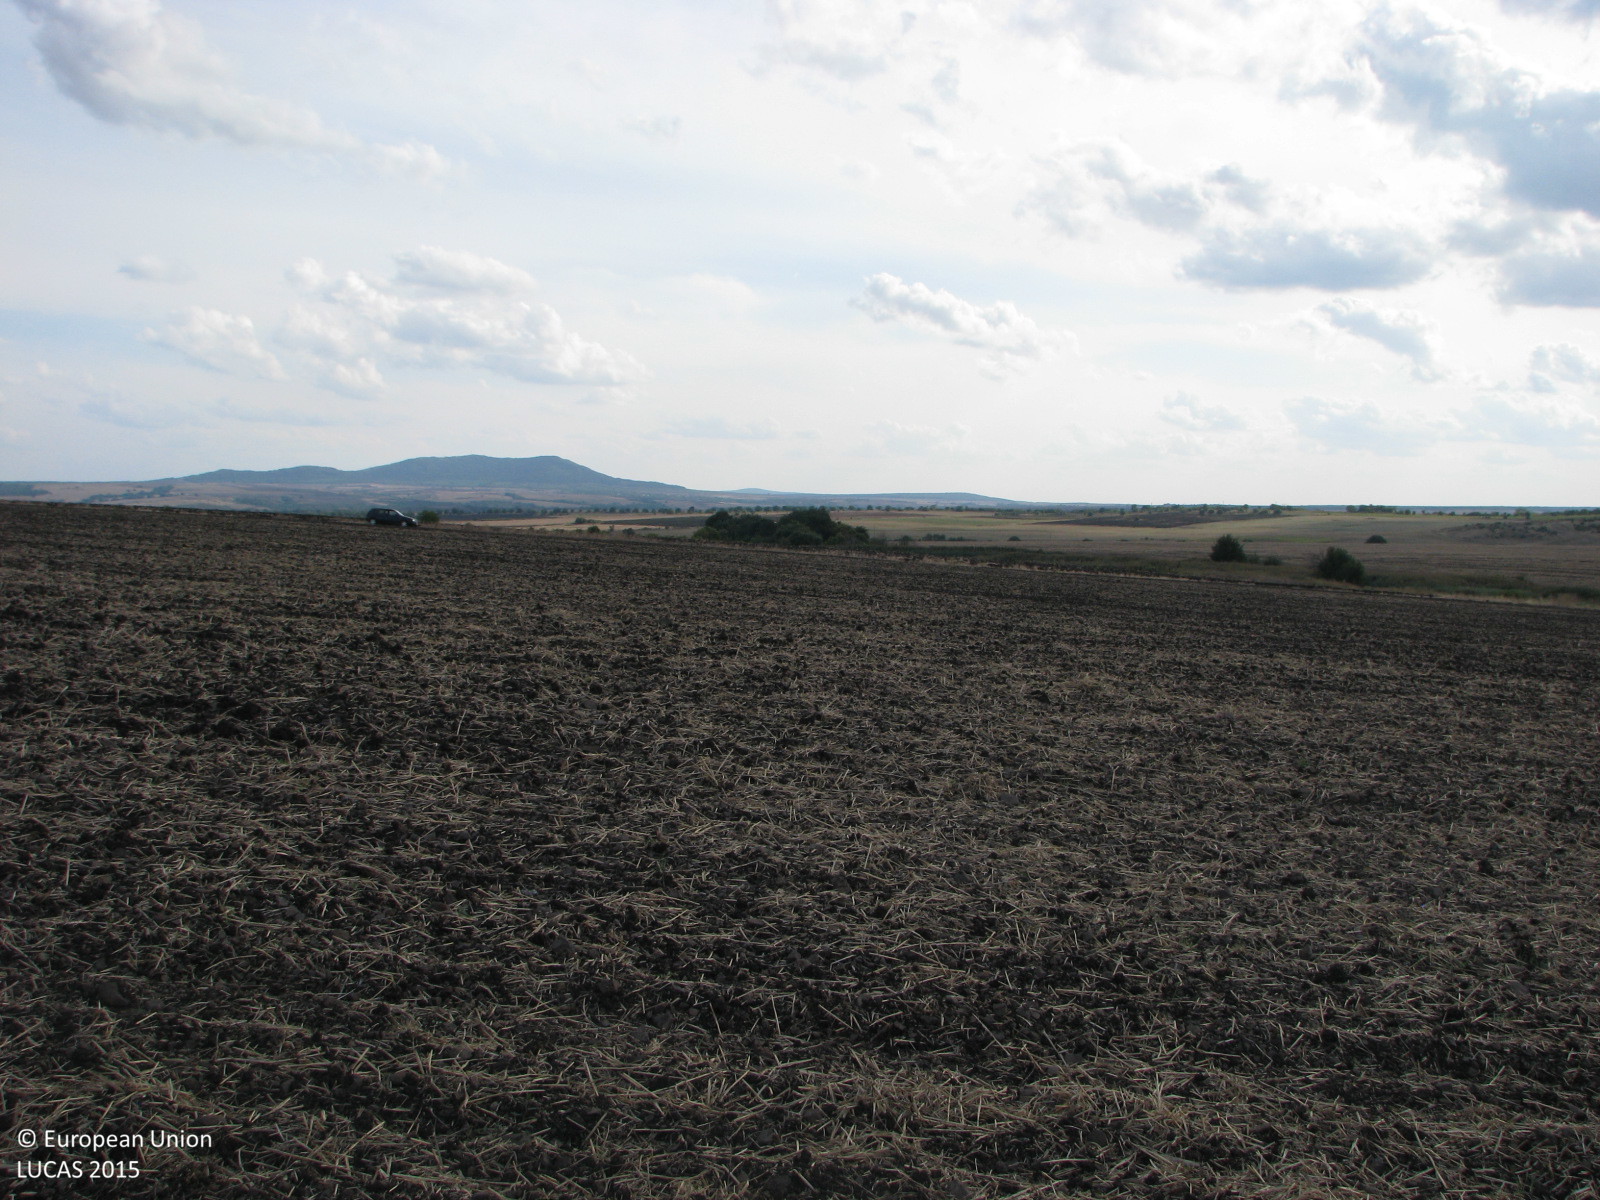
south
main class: Cropland
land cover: Common wheat
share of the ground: < 10 %
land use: Agriculture (excluding fallow land and kitchen gardens)
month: September
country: BG
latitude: 42.4642
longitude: 26.8468
